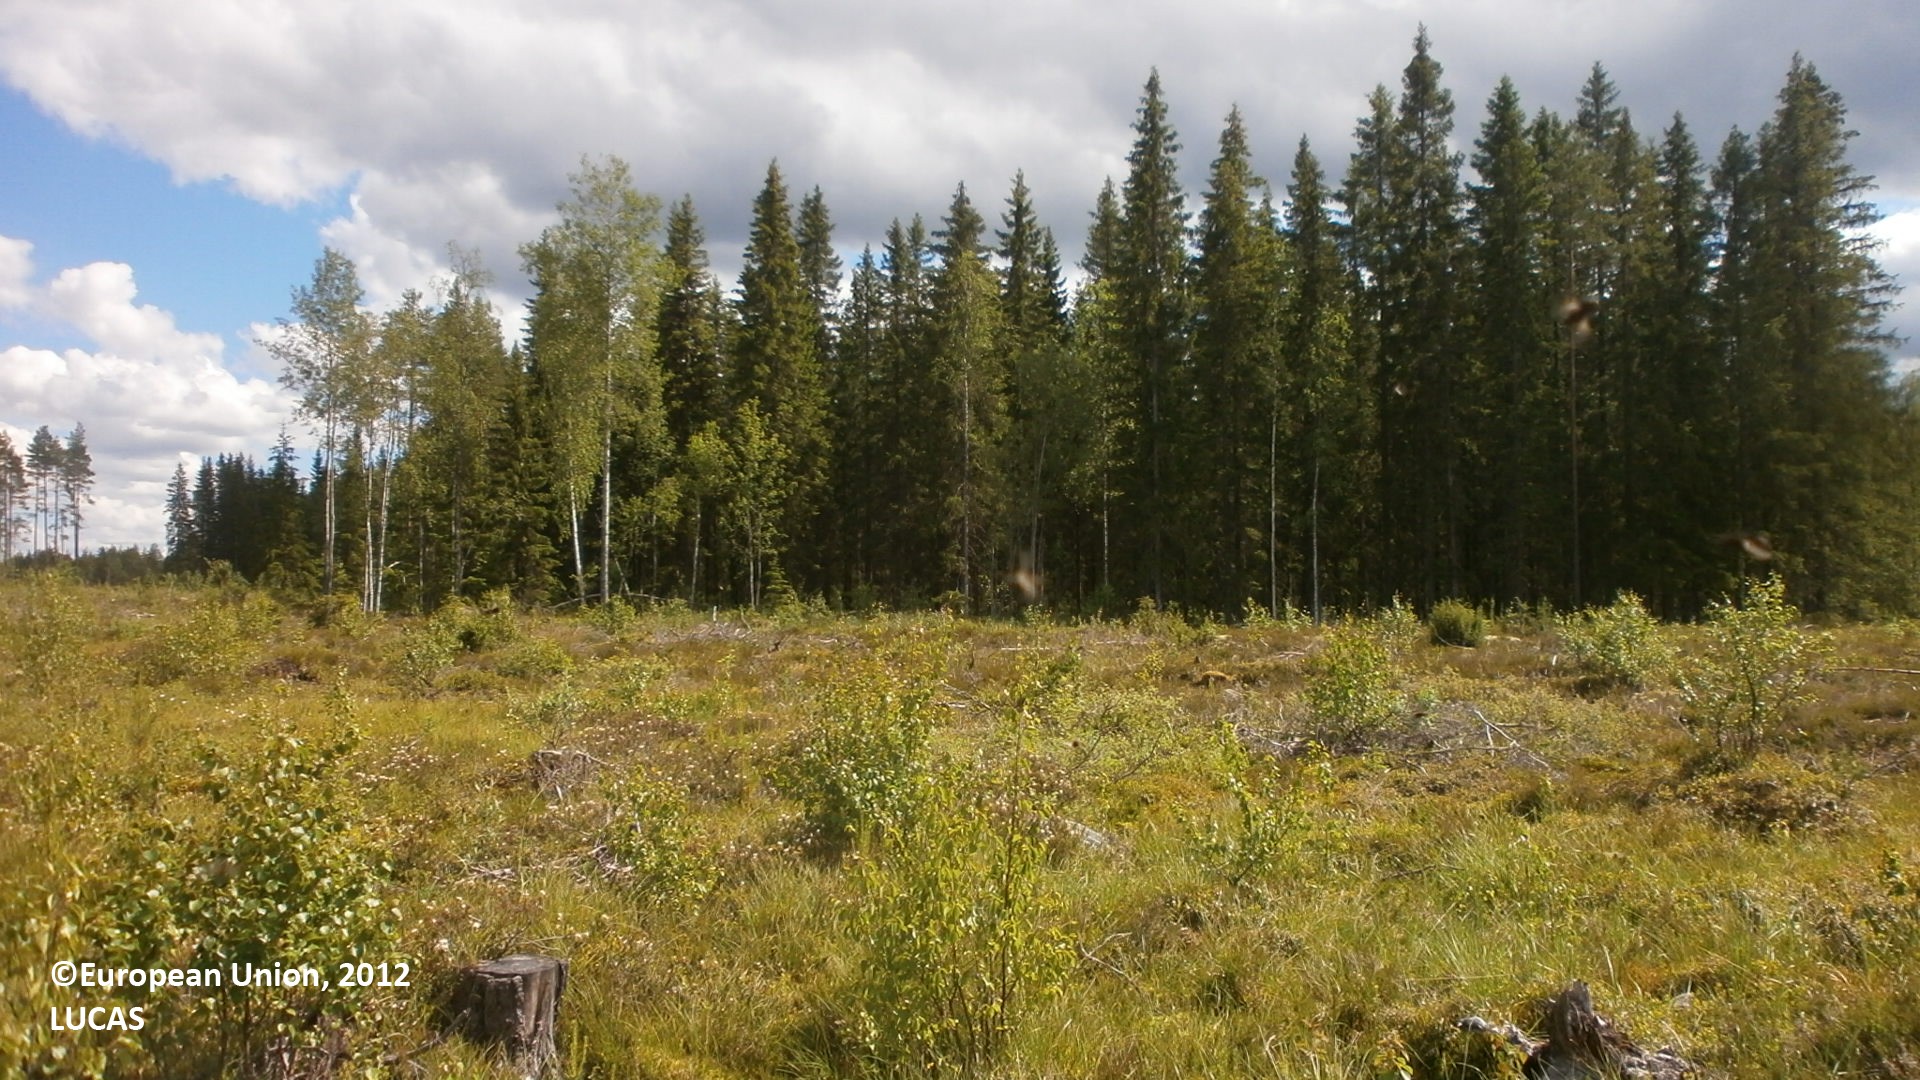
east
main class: Woodland
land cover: Other mixed woodland
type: boreal forest
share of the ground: 10 - 25 %
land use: Forestry
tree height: < 5 m
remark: Clear cut
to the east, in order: Other mixed woodland; Pine dominated mixed woodland; Broadleaved woodland; Spontaneously vegetated surfaces; Spruce dominated coniferous woodland
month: July
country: FI
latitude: 64.1250
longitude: 24.9726
